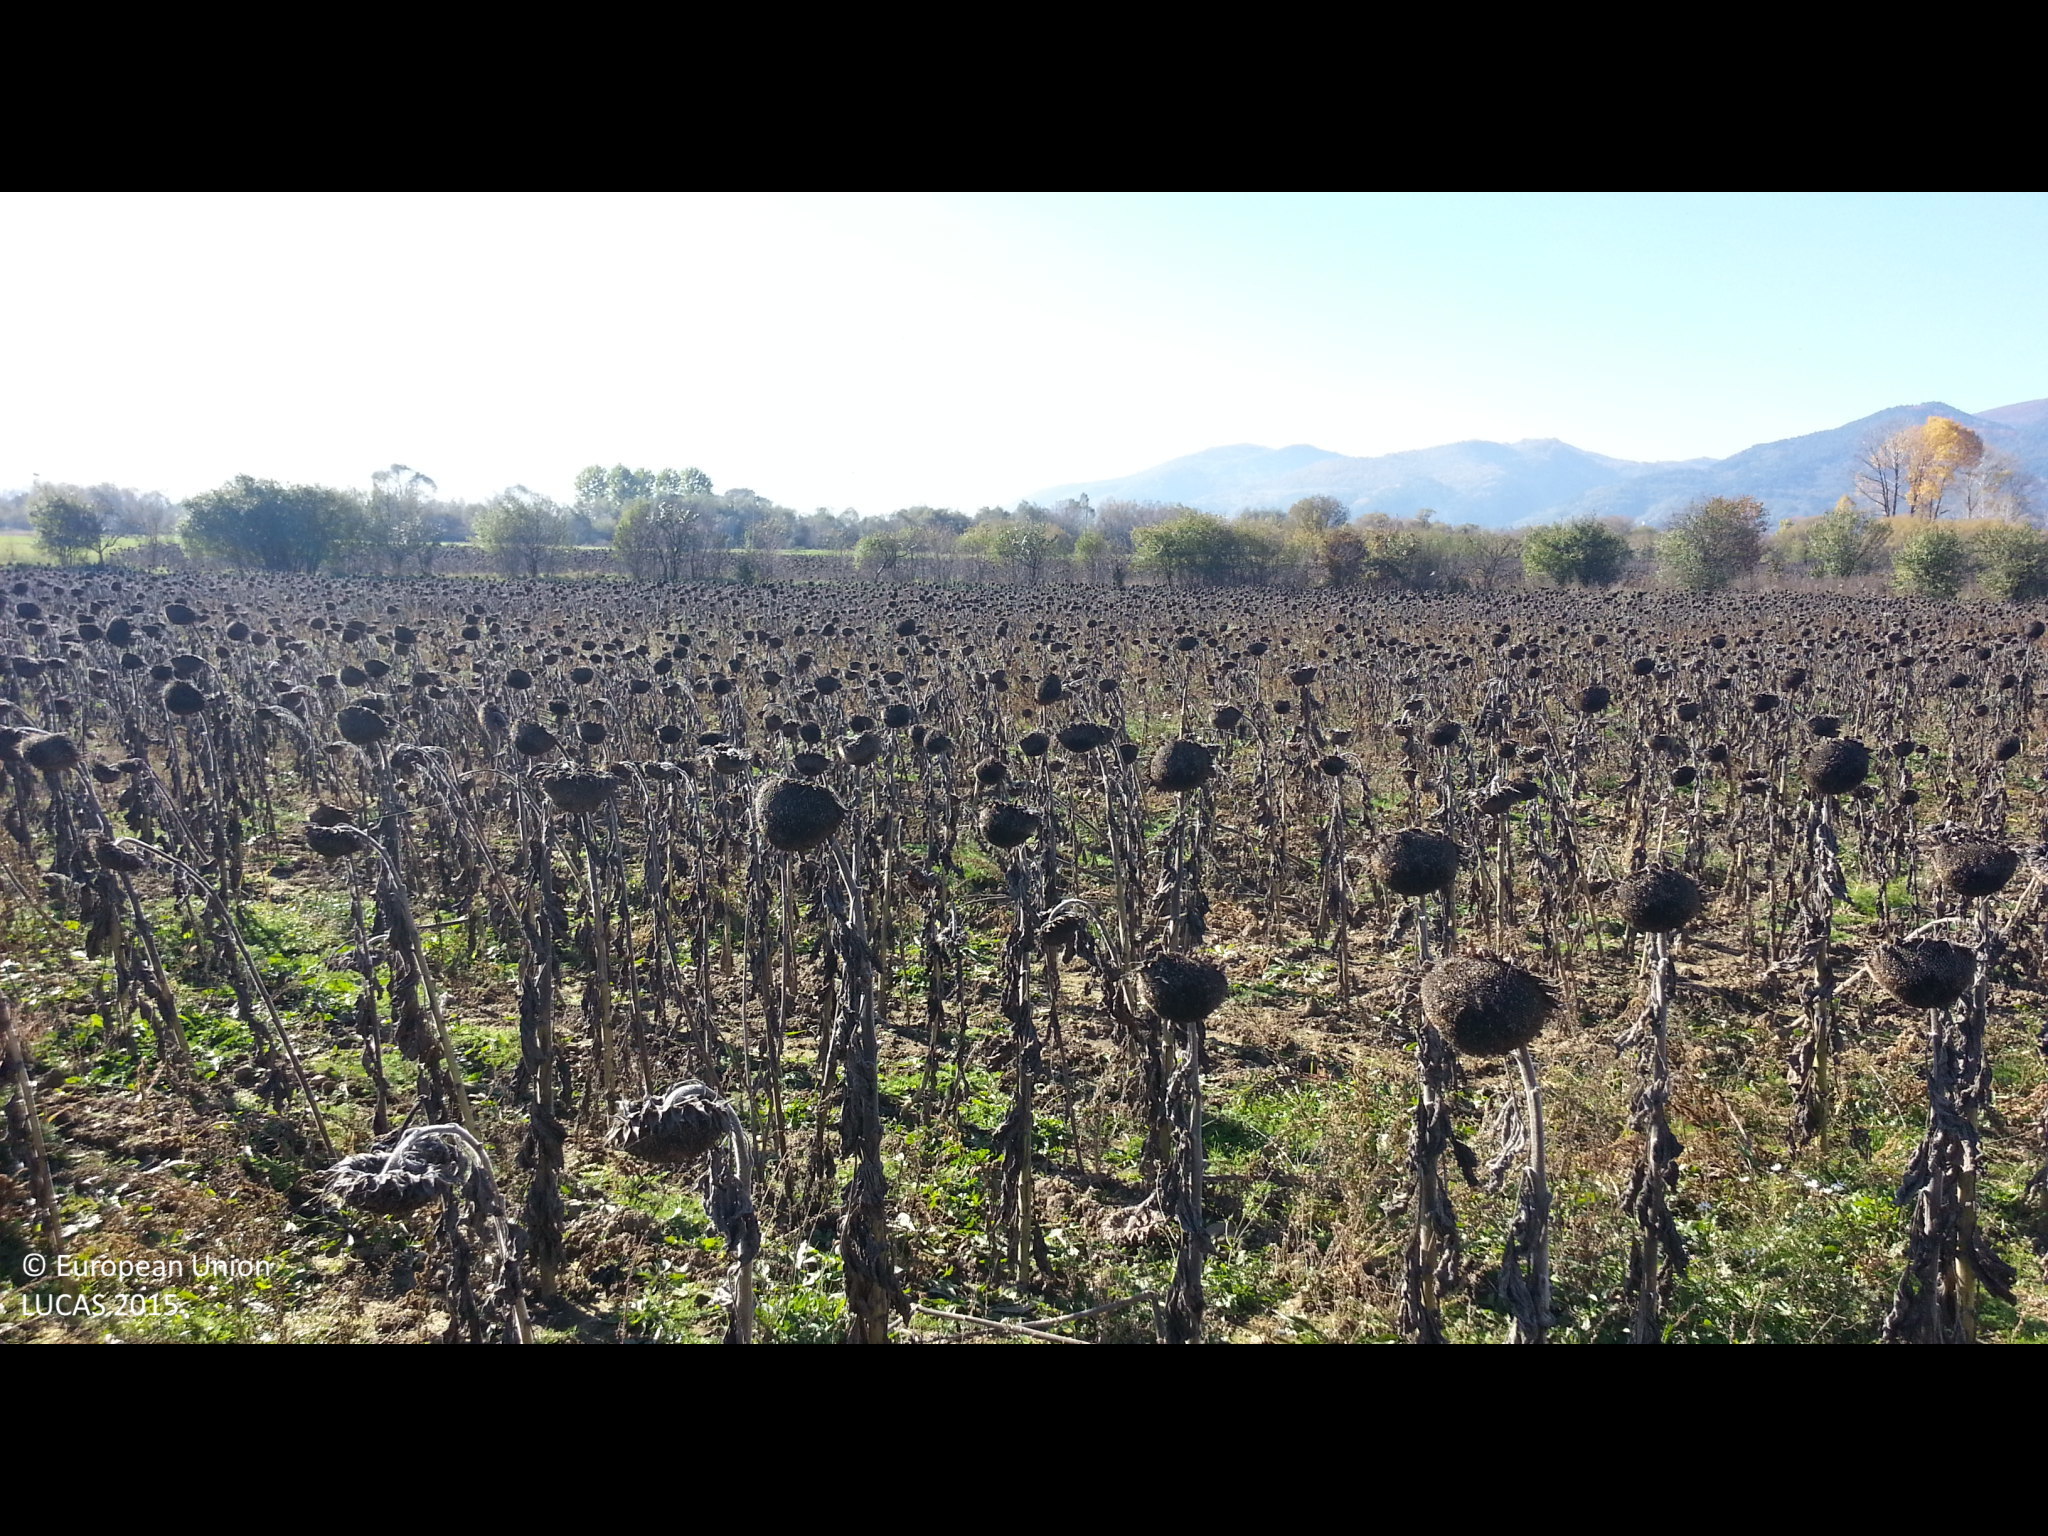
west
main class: Cropland
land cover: Sunflower
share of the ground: 50 - 75 %
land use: Agriculture (excluding fallow land and kitchen gardens)
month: November
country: BG
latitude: 42.7022
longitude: 24.1225
